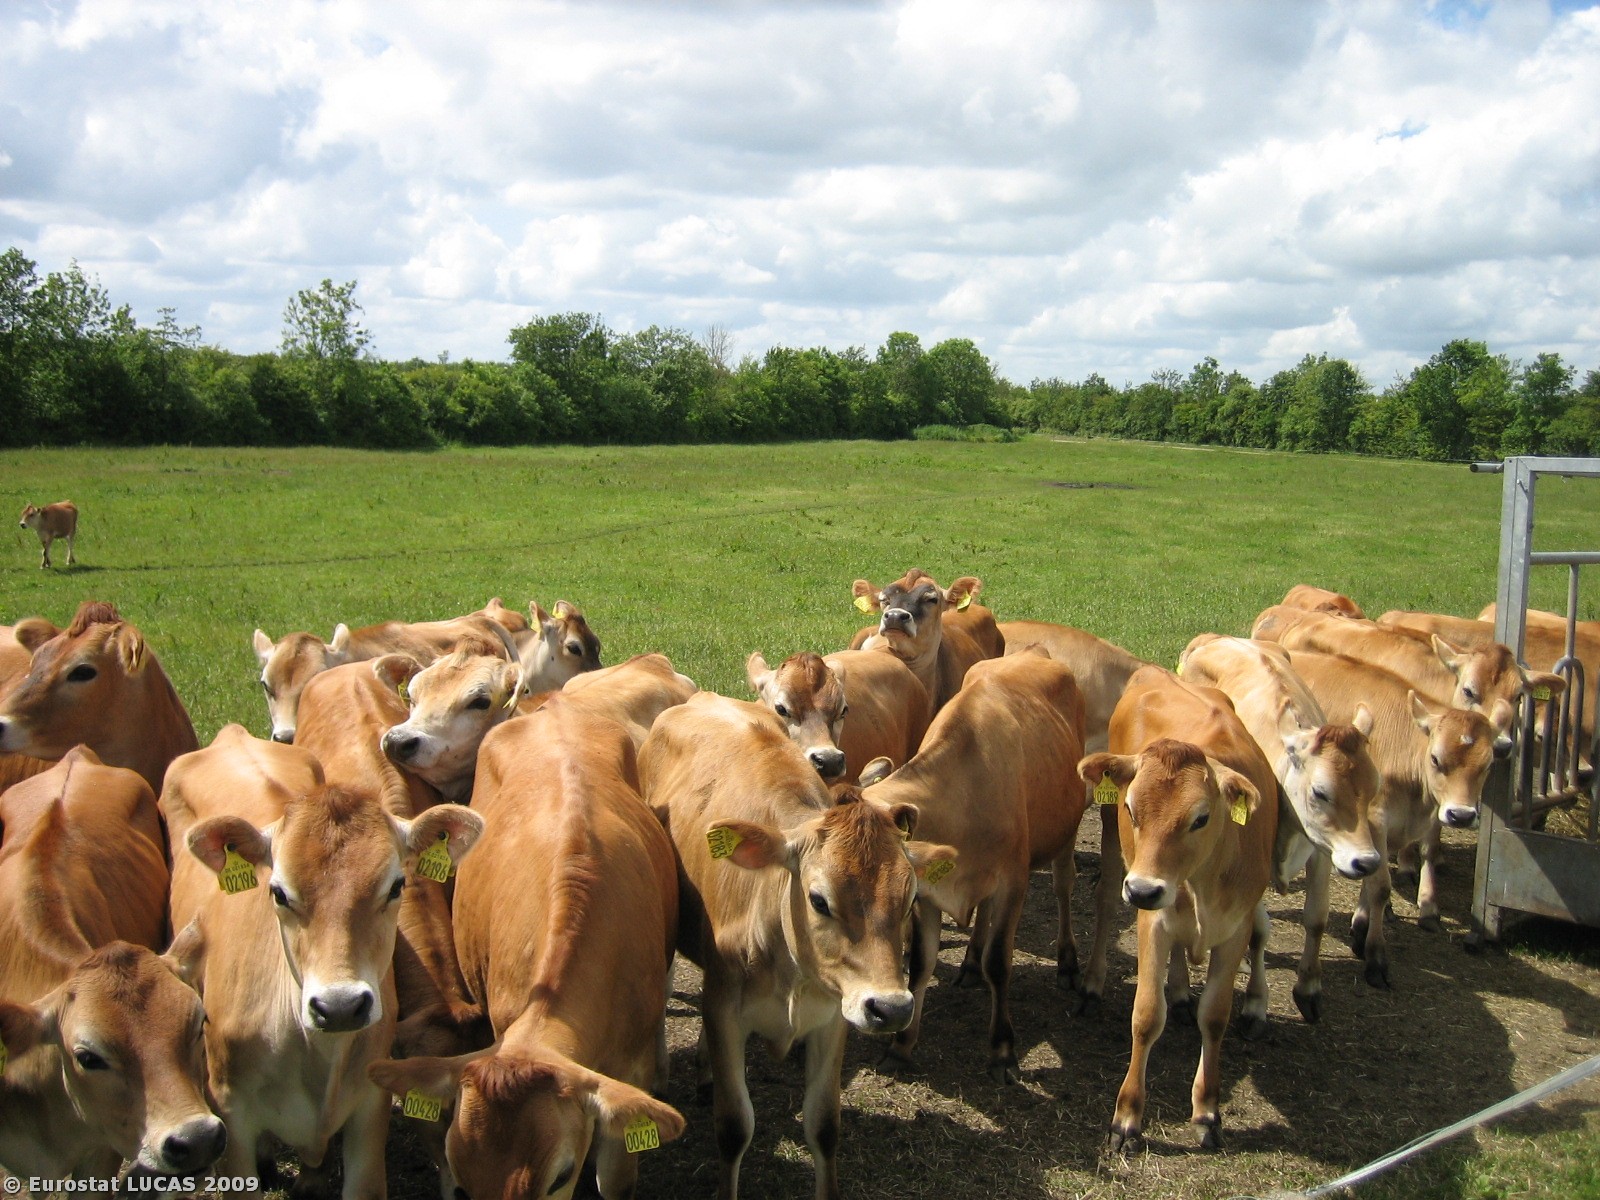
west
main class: Grassland
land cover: Grassland without tree/shrub cover
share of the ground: 10 - 25 %
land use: Agriculture (excluding fallow land and kitchen gardens)
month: June
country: DK
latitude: 55.7360
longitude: 9.2204
